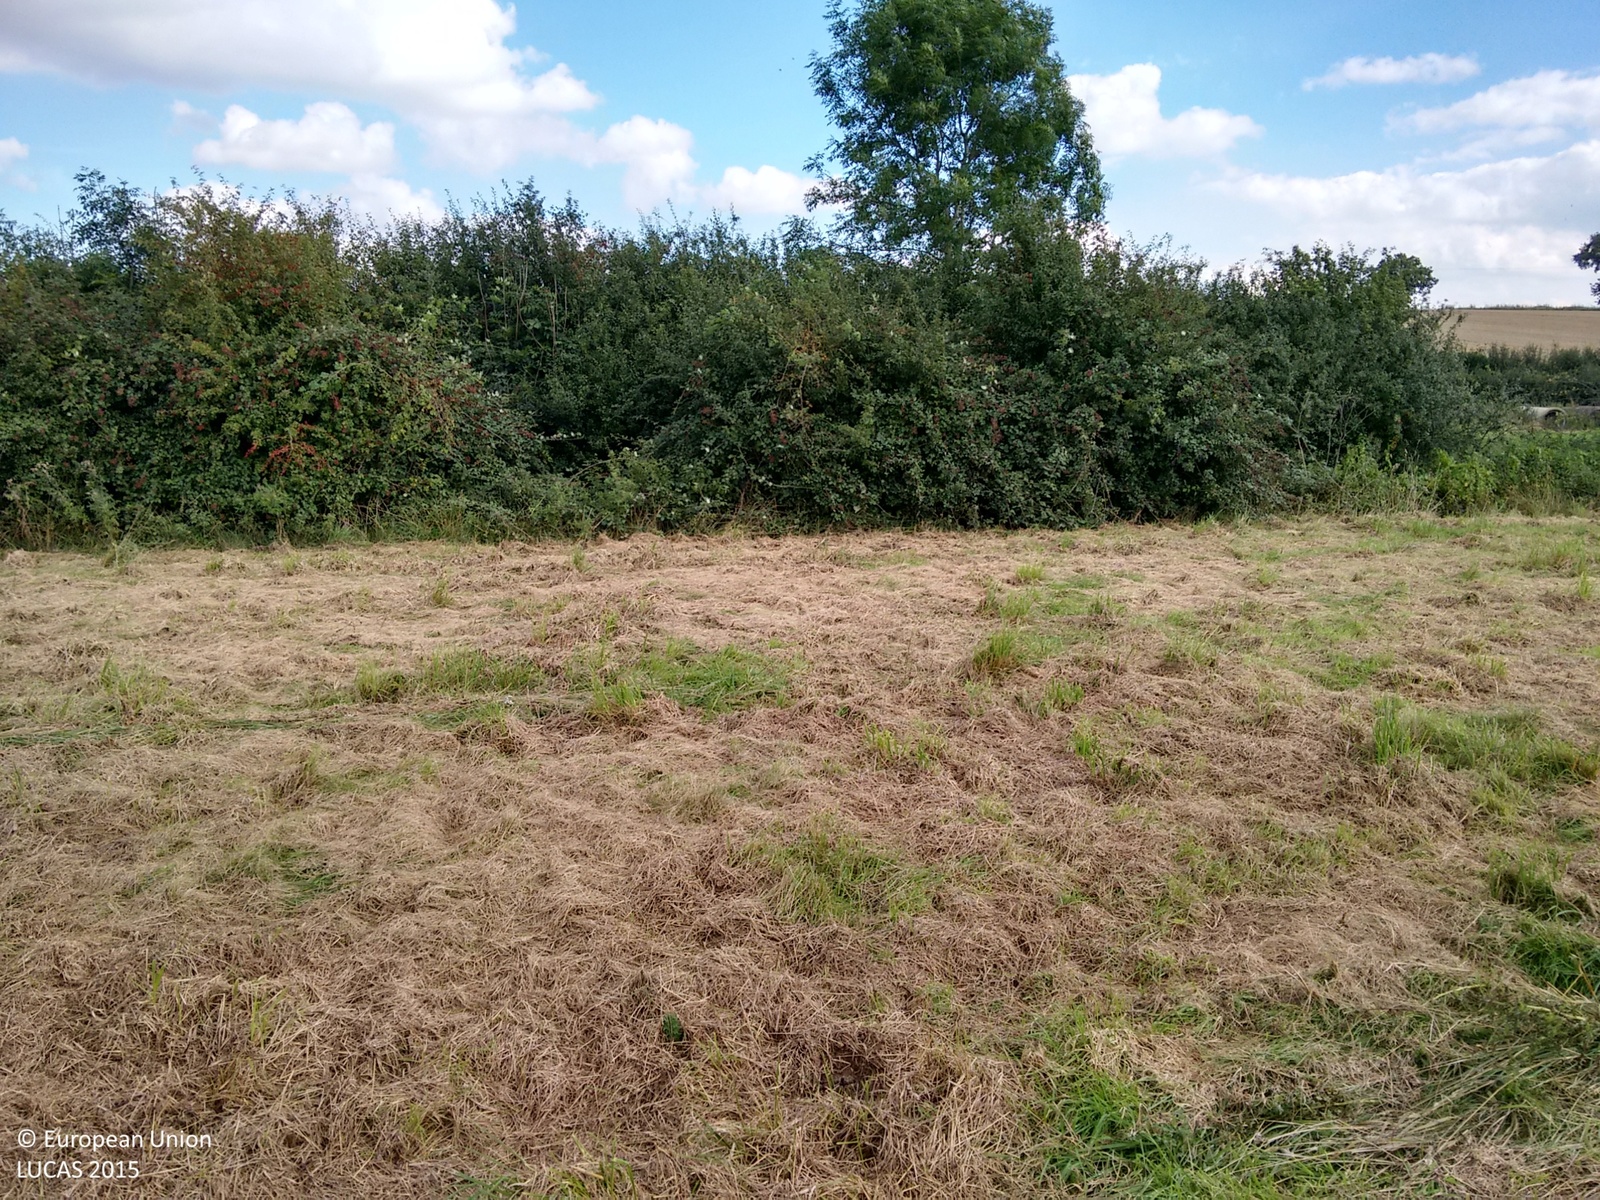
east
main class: Grassland
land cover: Grassland without tree/shrub cover
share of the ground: > 75 %
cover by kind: herbaceous plants 100 %
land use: Agriculture (excluding fallow land and kitchen gardens)
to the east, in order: Grassland without tree/shrub cover; Abandoned hedges; Ditches and canals; Abandoned hedges; Grassland without tree/shrub cover; Ditches and canals; Abandoned hedges; Grass margins; Paved roads, cycling and walking lanes; Grass margins; Ditches and canals; Abandoned hedges; Grass margins; Common wheat; Electric lines; Common wheat
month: September
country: GB
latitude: 52.5298
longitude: 1.3268
